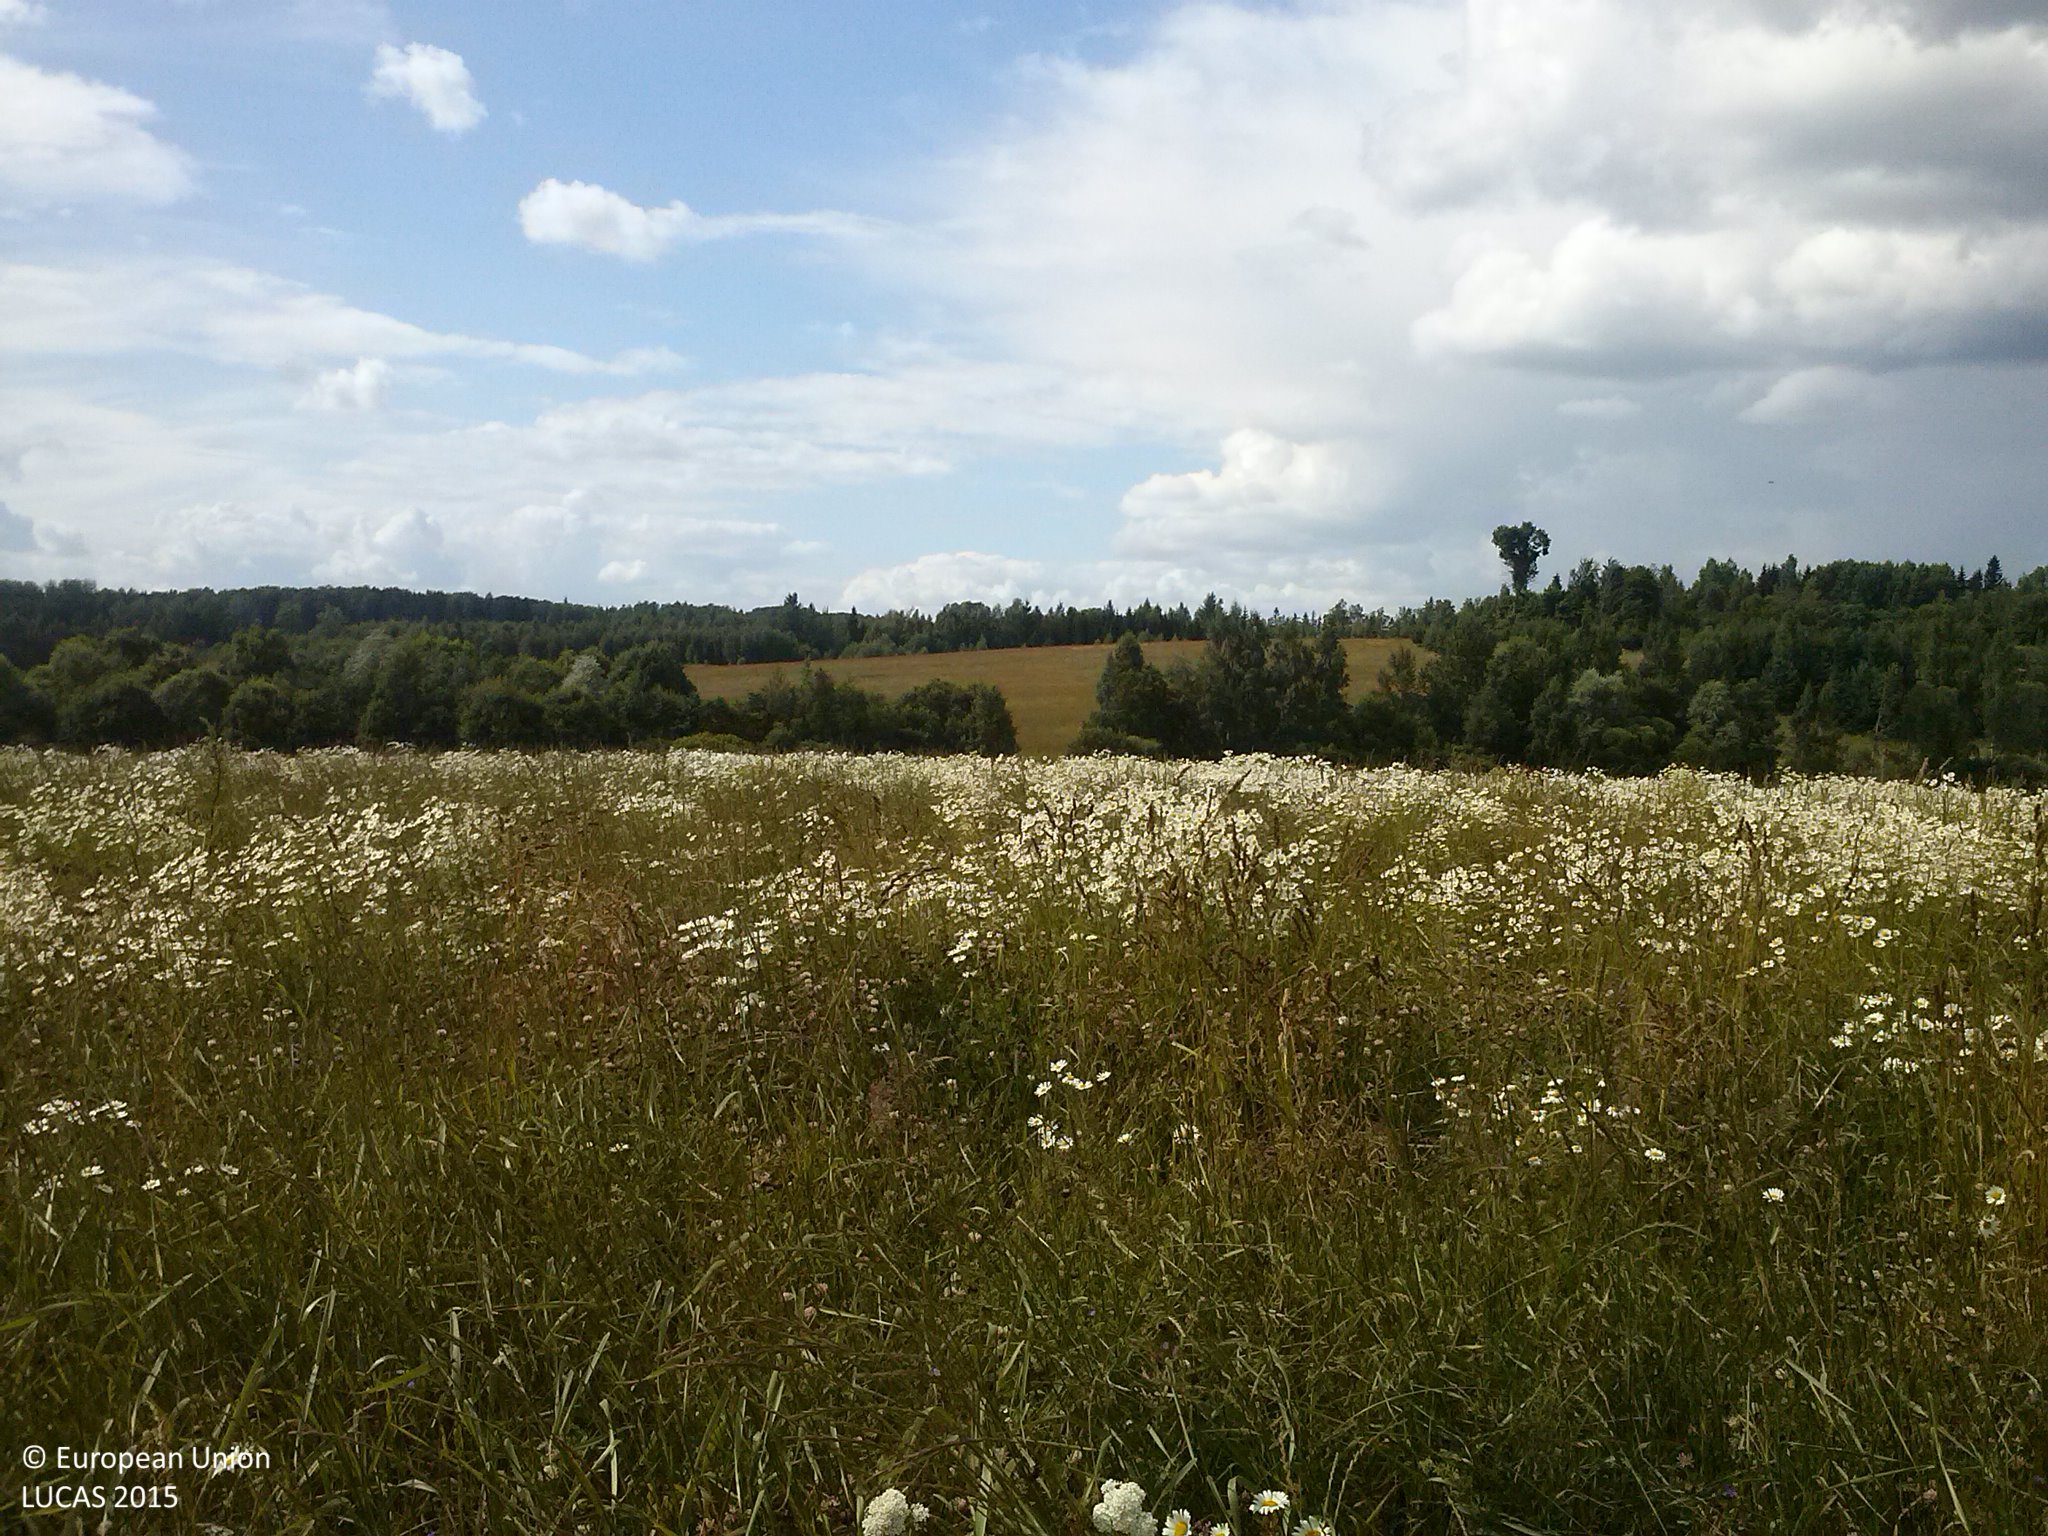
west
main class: Grassland
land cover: Grassland without tree/shrub cover
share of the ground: > 75 %
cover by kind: herbaceous plants 100 %
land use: Agriculture (excluding fallow land and kitchen gardens)
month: July
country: LV
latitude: 56.6047
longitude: 27.2930
